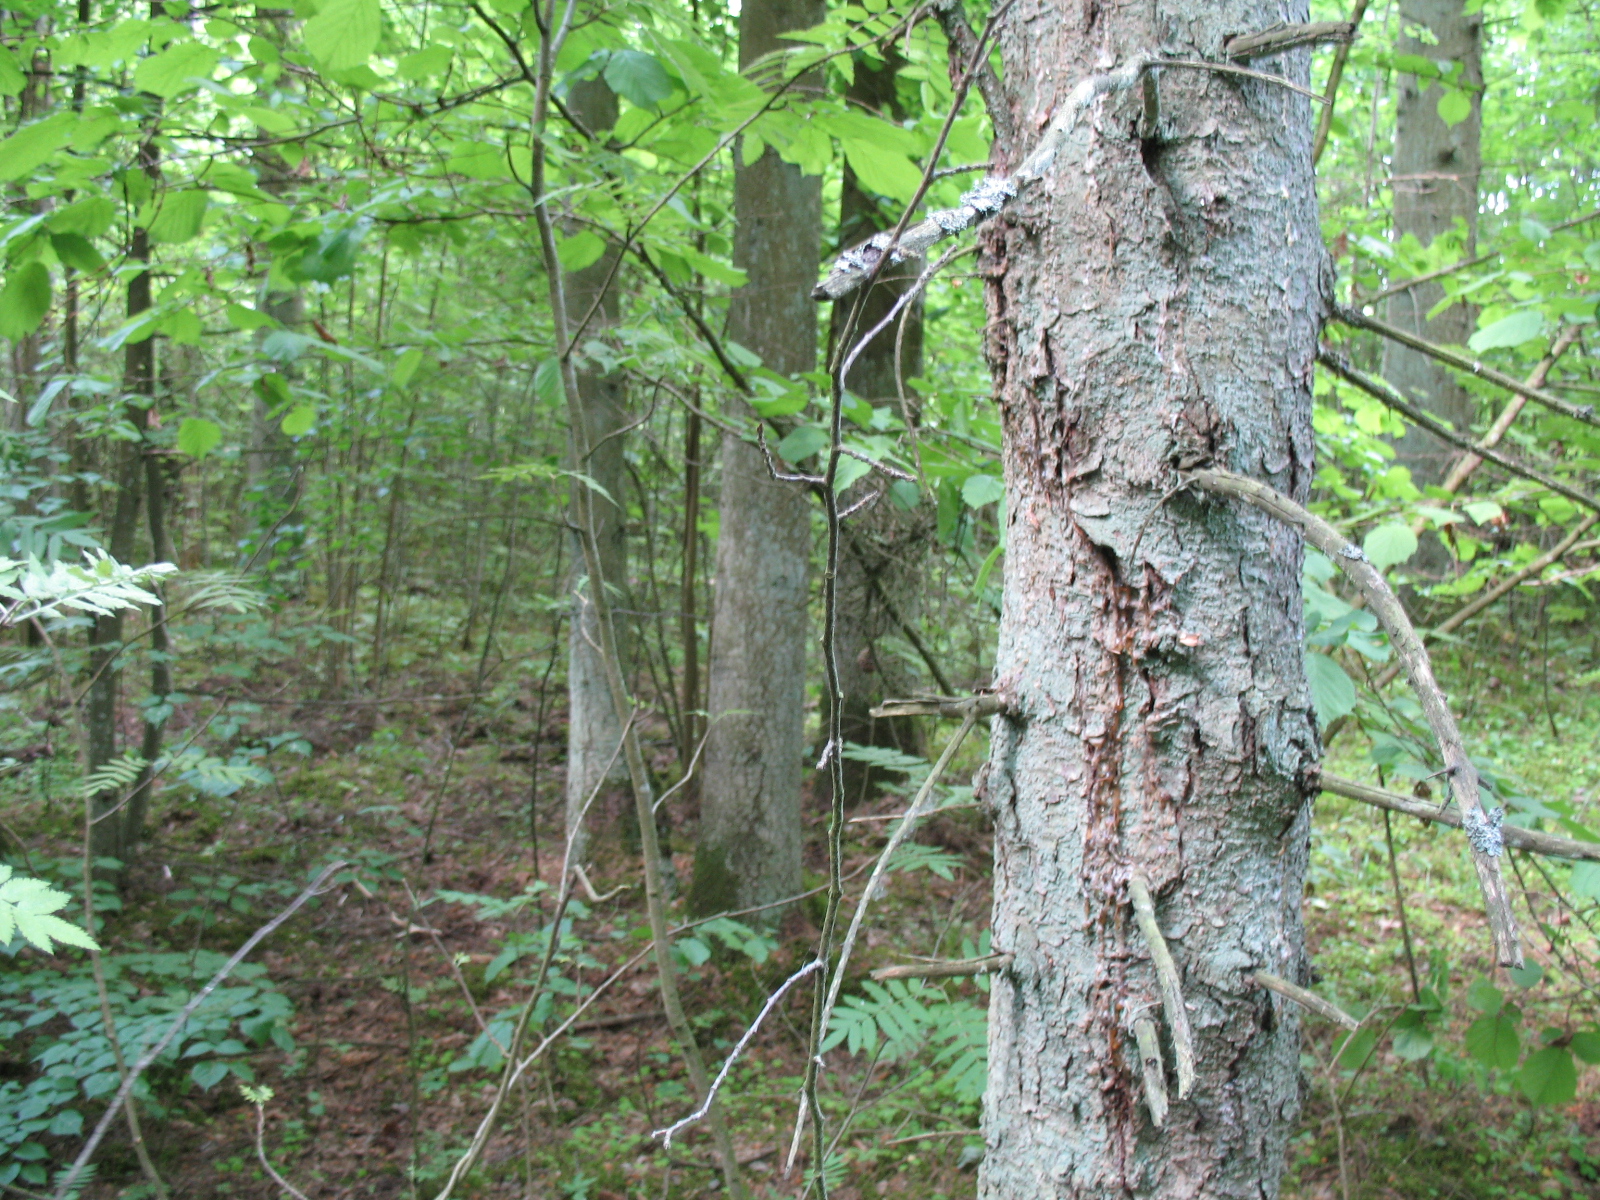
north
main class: Woodland
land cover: Spruce dominated coniferous woodland
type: hemiboreal forest and nemoral coniferous forest and mixed broadleaved-coniferous forest
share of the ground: > 75 %
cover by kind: coniferous forest trees 90 %, shrubs 10 %
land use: Forestry
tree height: > 5 m
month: June
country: LV
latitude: 56.4281
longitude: 23.4185
